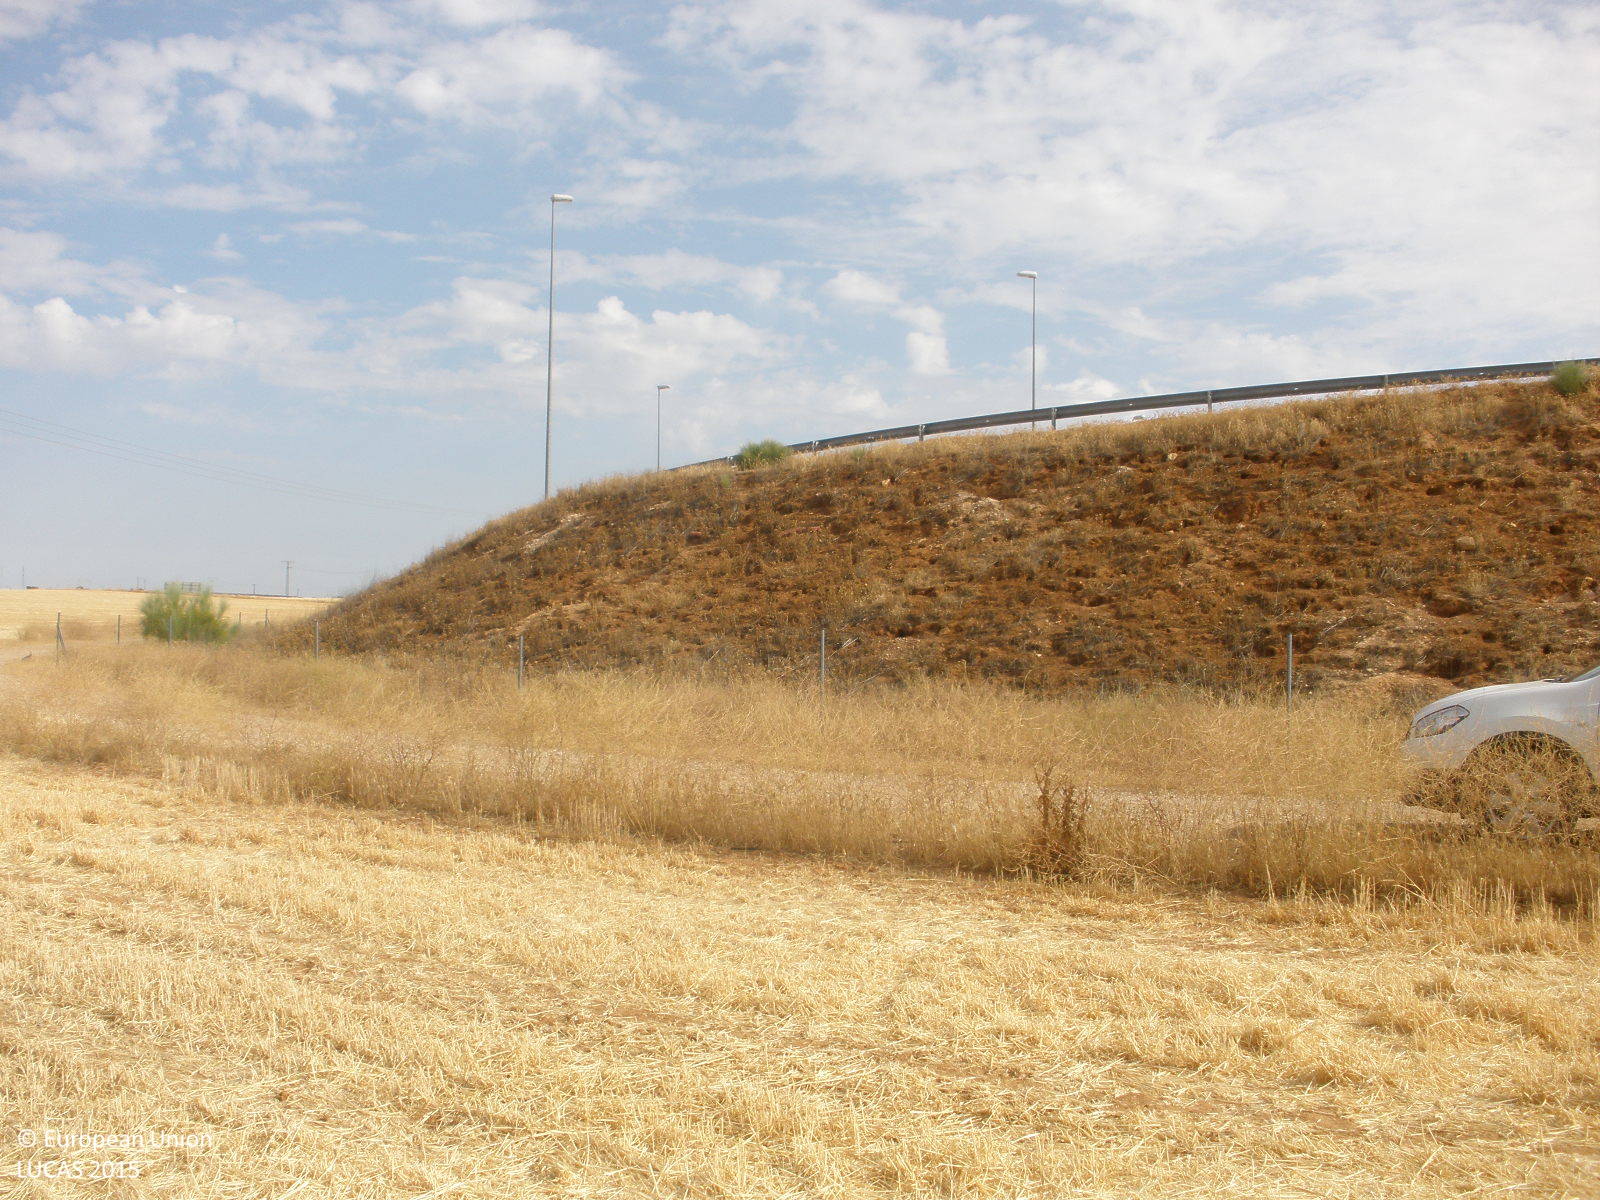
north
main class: Cropland
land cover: Barley
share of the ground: < 10 %
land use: Agriculture (excluding fallow land and kitchen gardens)
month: July
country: ES
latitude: 39.7912
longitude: -3.2074
